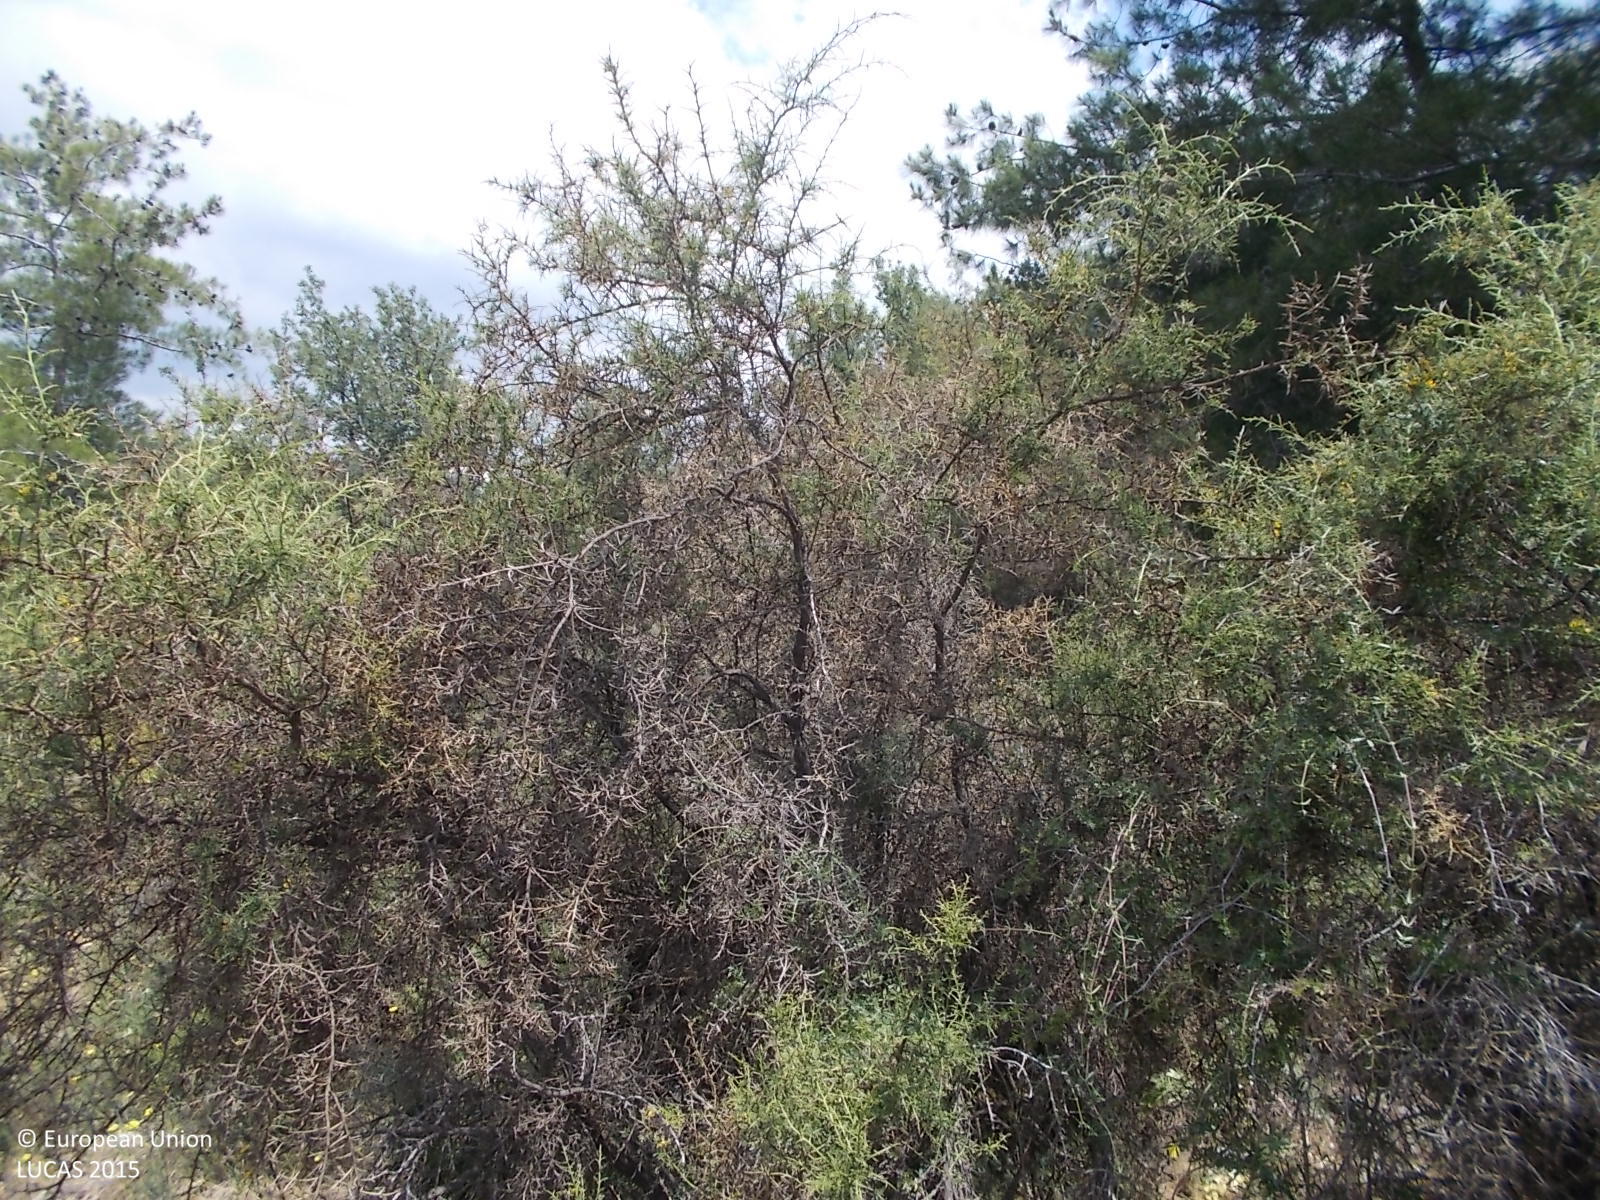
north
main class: Shrubland
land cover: Shrubland with sparse tree cover
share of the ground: > 75 %
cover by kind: shrubs 85 %, unconsolidated bare surface 10 %, broadleaved forest trees 5 %
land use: Semi-natural and natural areas not in use
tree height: > 5 m
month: June
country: CY
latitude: 34.8758
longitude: 32.7518
